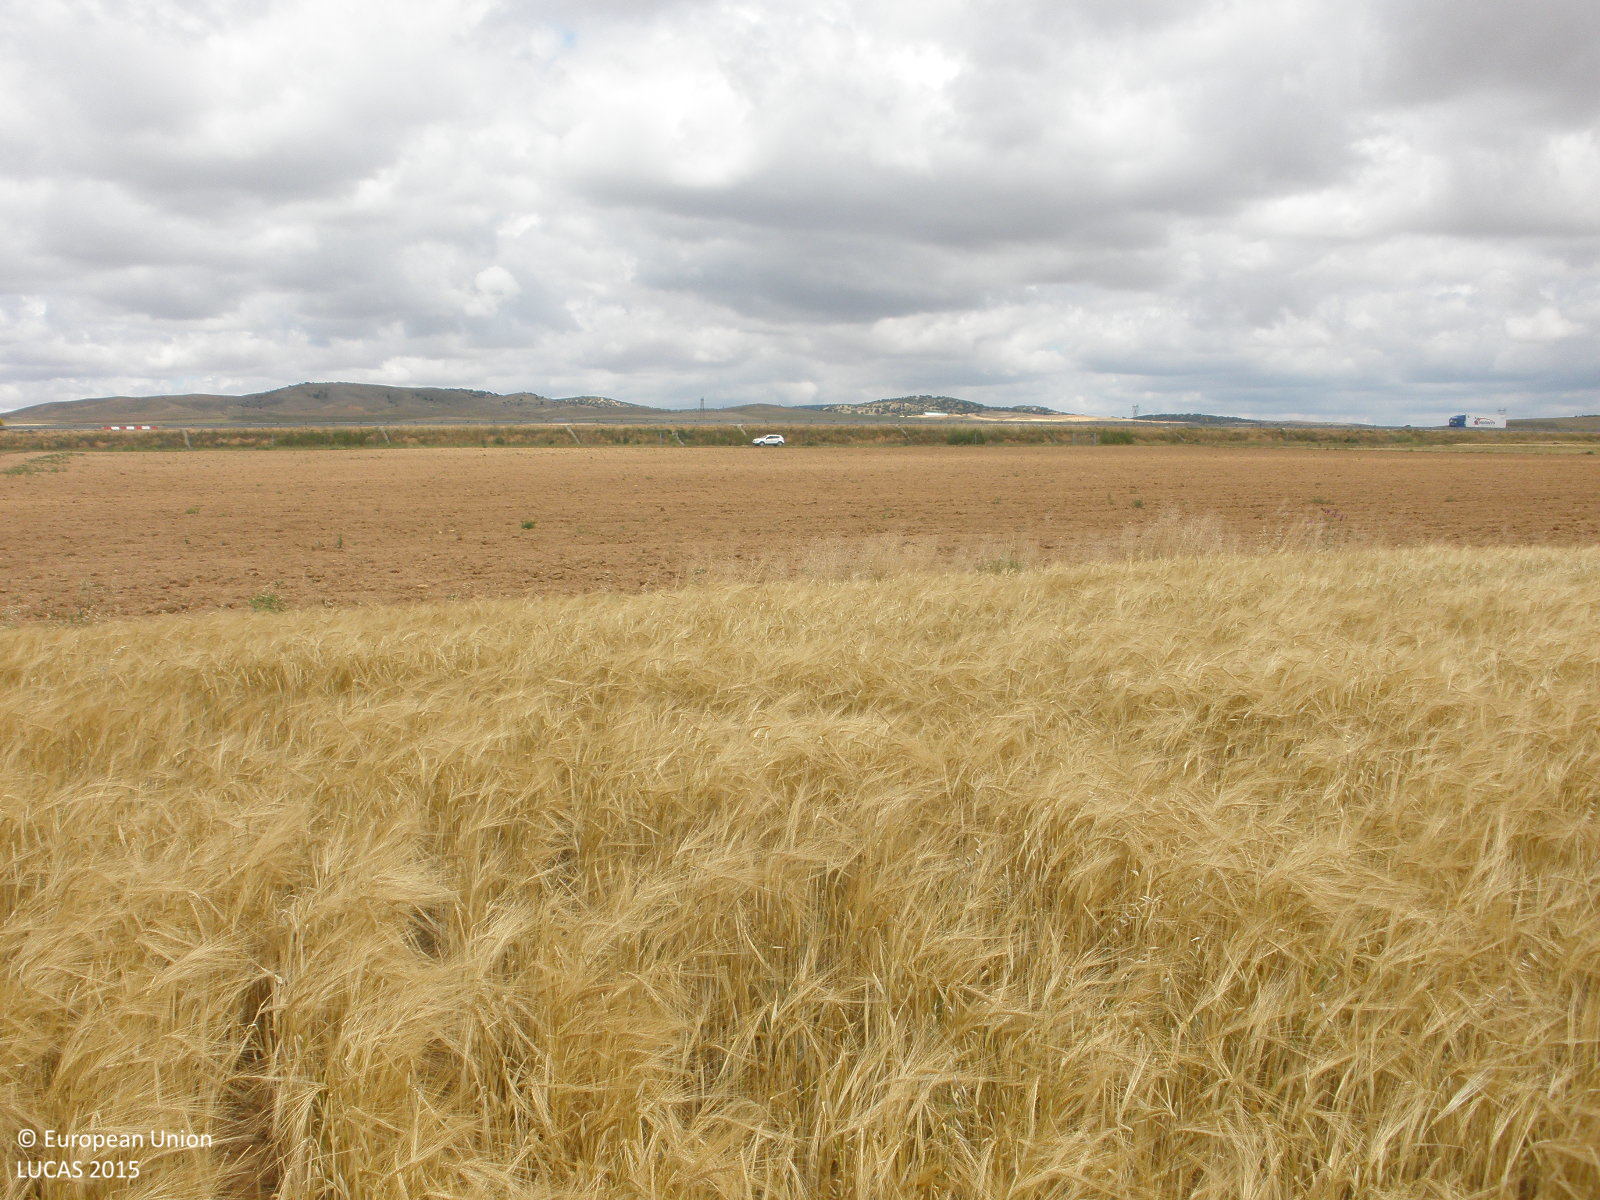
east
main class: Cropland
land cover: Barley
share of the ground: > 75 %
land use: Agriculture (excluding fallow land and kitchen gardens)
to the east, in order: Barley; Grass margins; Other bare soil; Grass margins; Tracks
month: June
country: ES
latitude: 40.5289
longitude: -1.2637
